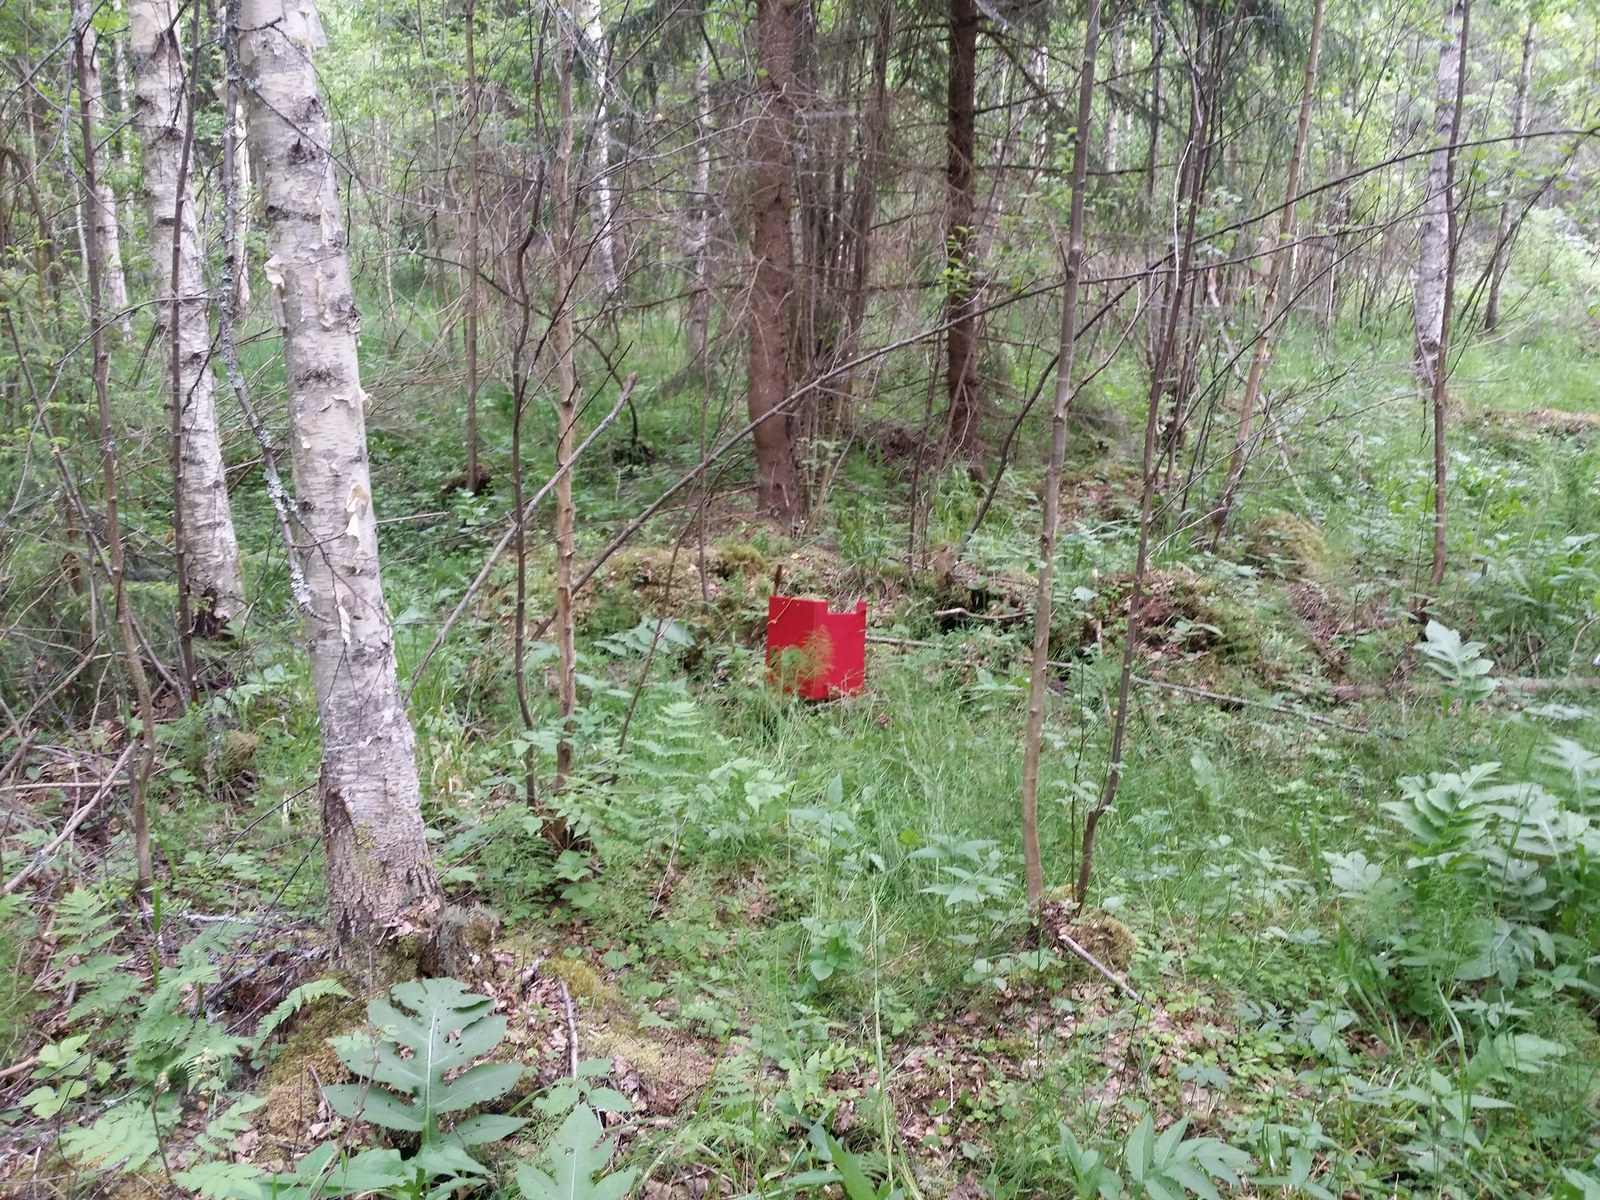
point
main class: Woodland
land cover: Spruce dominated mixed woodland
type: hemiboreal forest and nemoral coniferous forest and mixed broadleaved-coniferous forest
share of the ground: > 75 %
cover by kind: coniferous forest trees 45 %, broadleaved forest trees 35 %, herbaceous plants 10 %, lichens and mosses 10 %
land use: Forestry
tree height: > 5 m
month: June
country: LV
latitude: 57.3433
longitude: 26.4421
